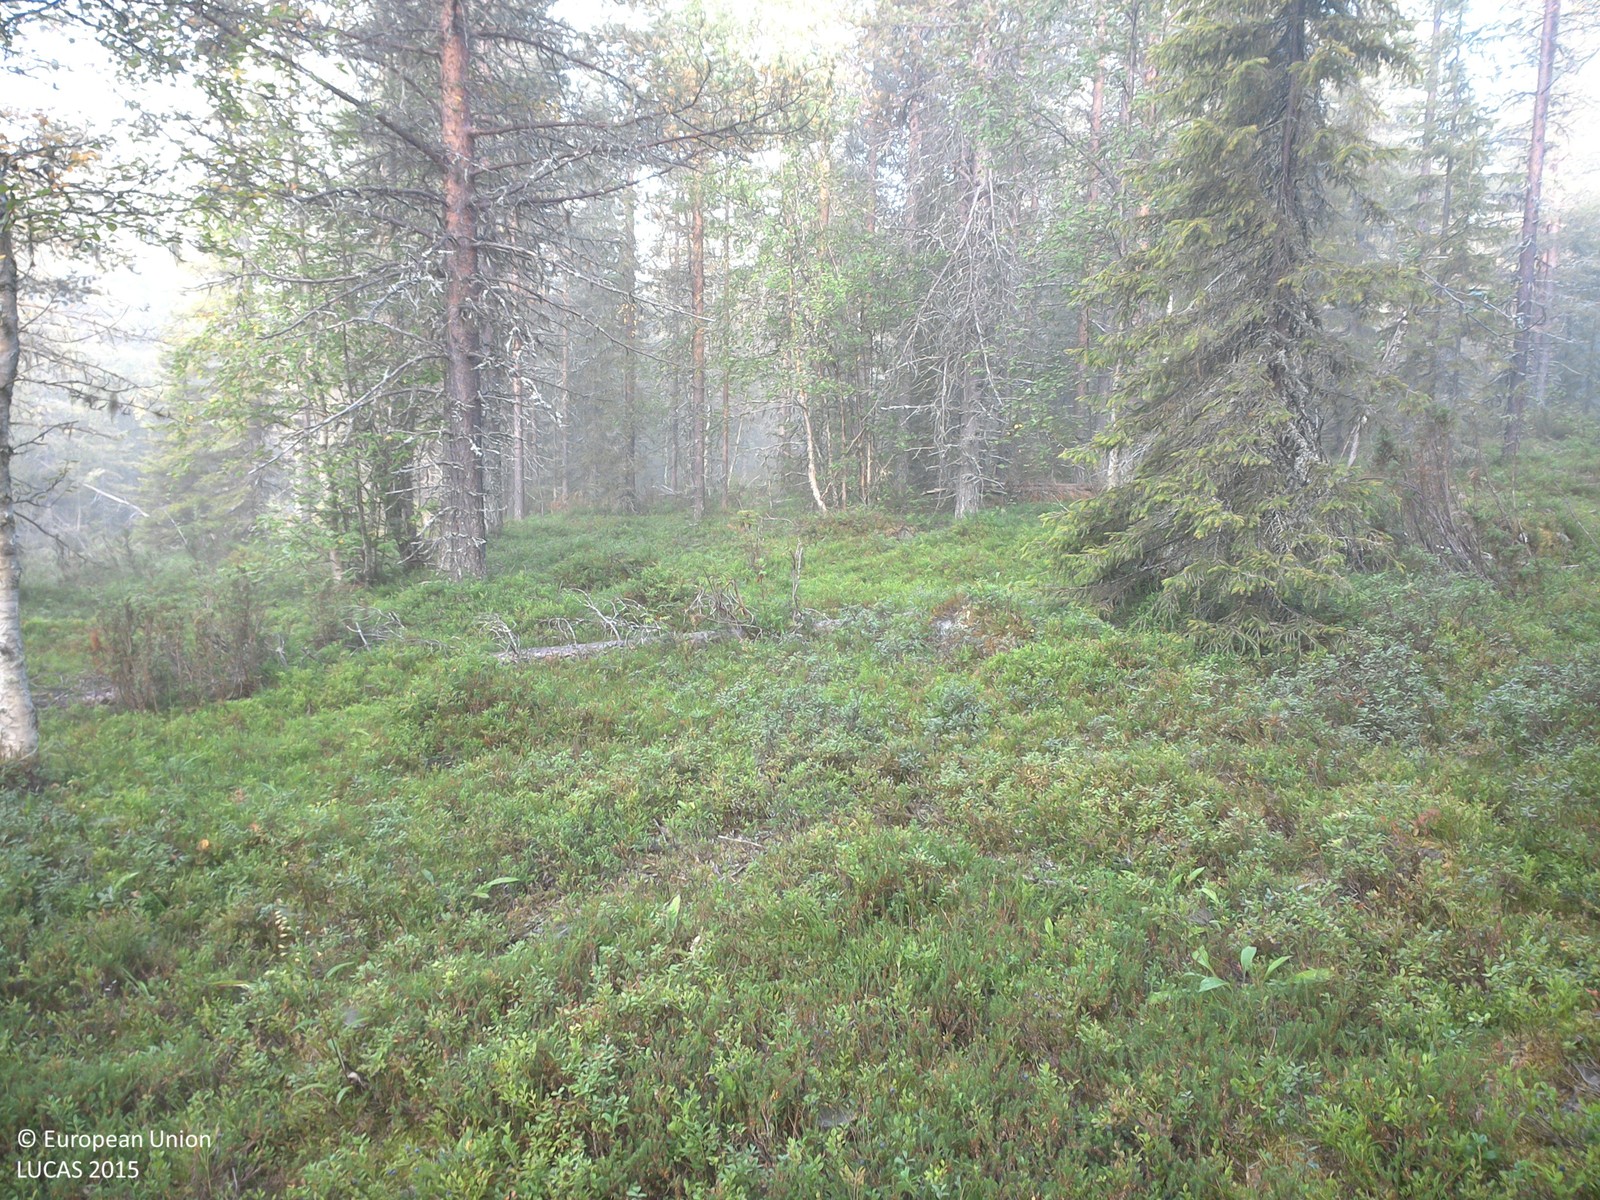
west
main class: Woodland
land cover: Pine dominated coniferous woodland
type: boreal forest
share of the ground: 25 - 50 %
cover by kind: shrubs 60 %, coniferous forest trees 30 %, broadleaved forest trees 5 %, lichens and mosses 5 %
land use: Forestry
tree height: > 5 m
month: August
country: SE
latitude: 67.1224
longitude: 21.8746
